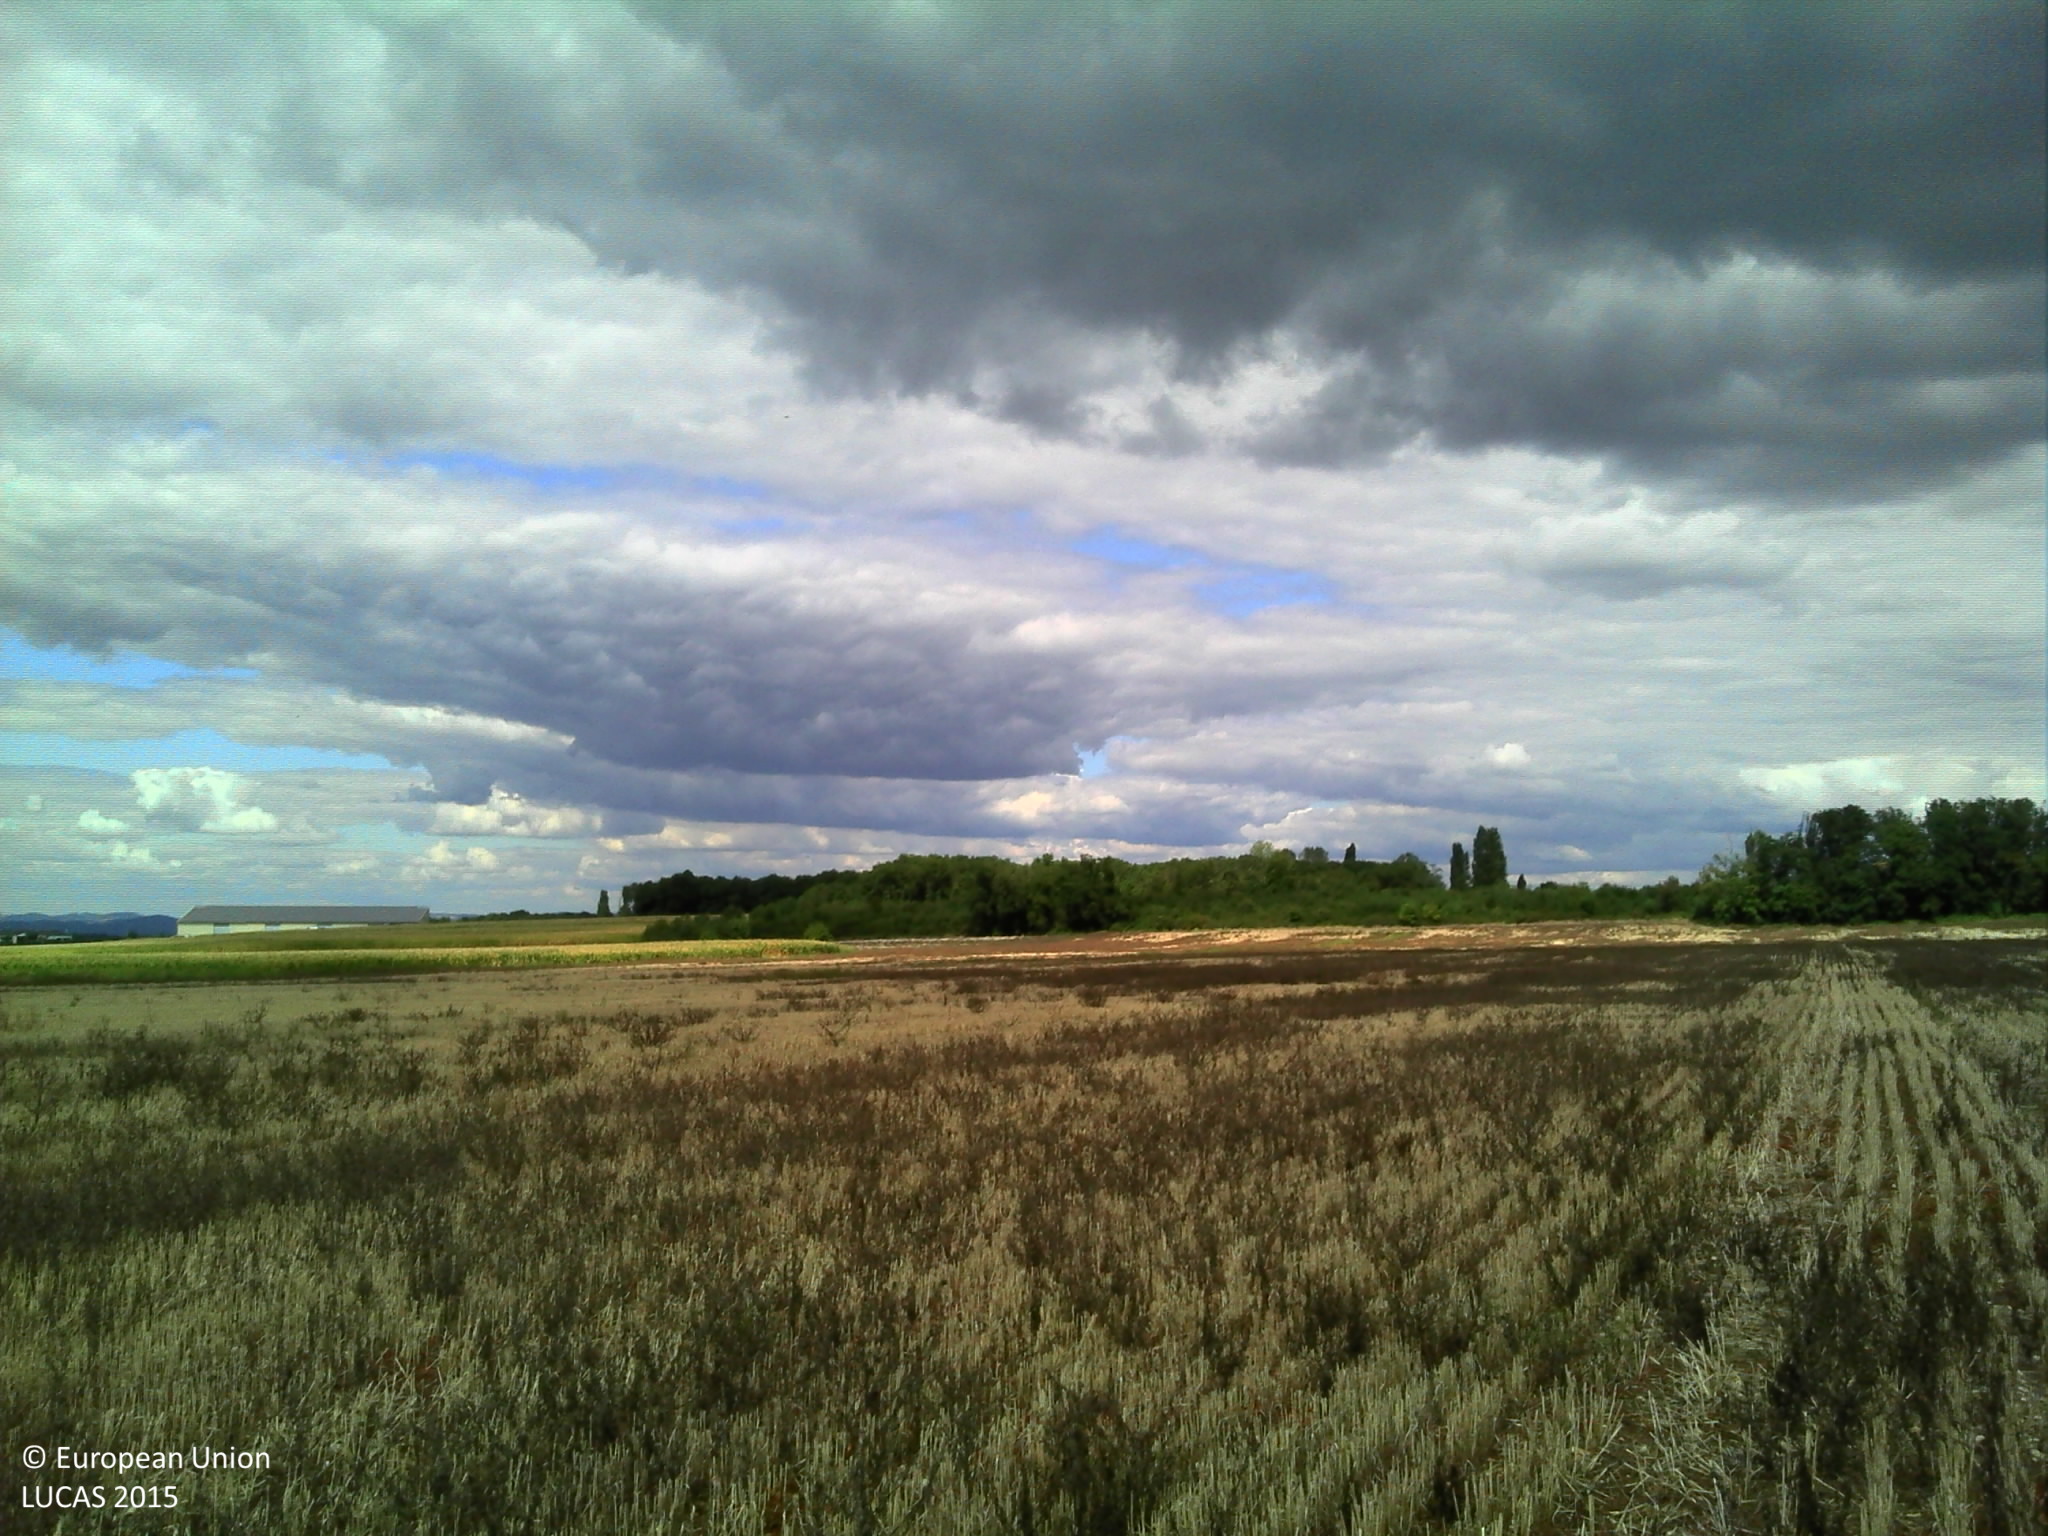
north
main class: Cropland
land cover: Common wheat
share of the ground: > 75 %
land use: Agriculture (excluding fallow land and kitchen gardens)
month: September
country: FR
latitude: 44.9370
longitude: 5.0511
